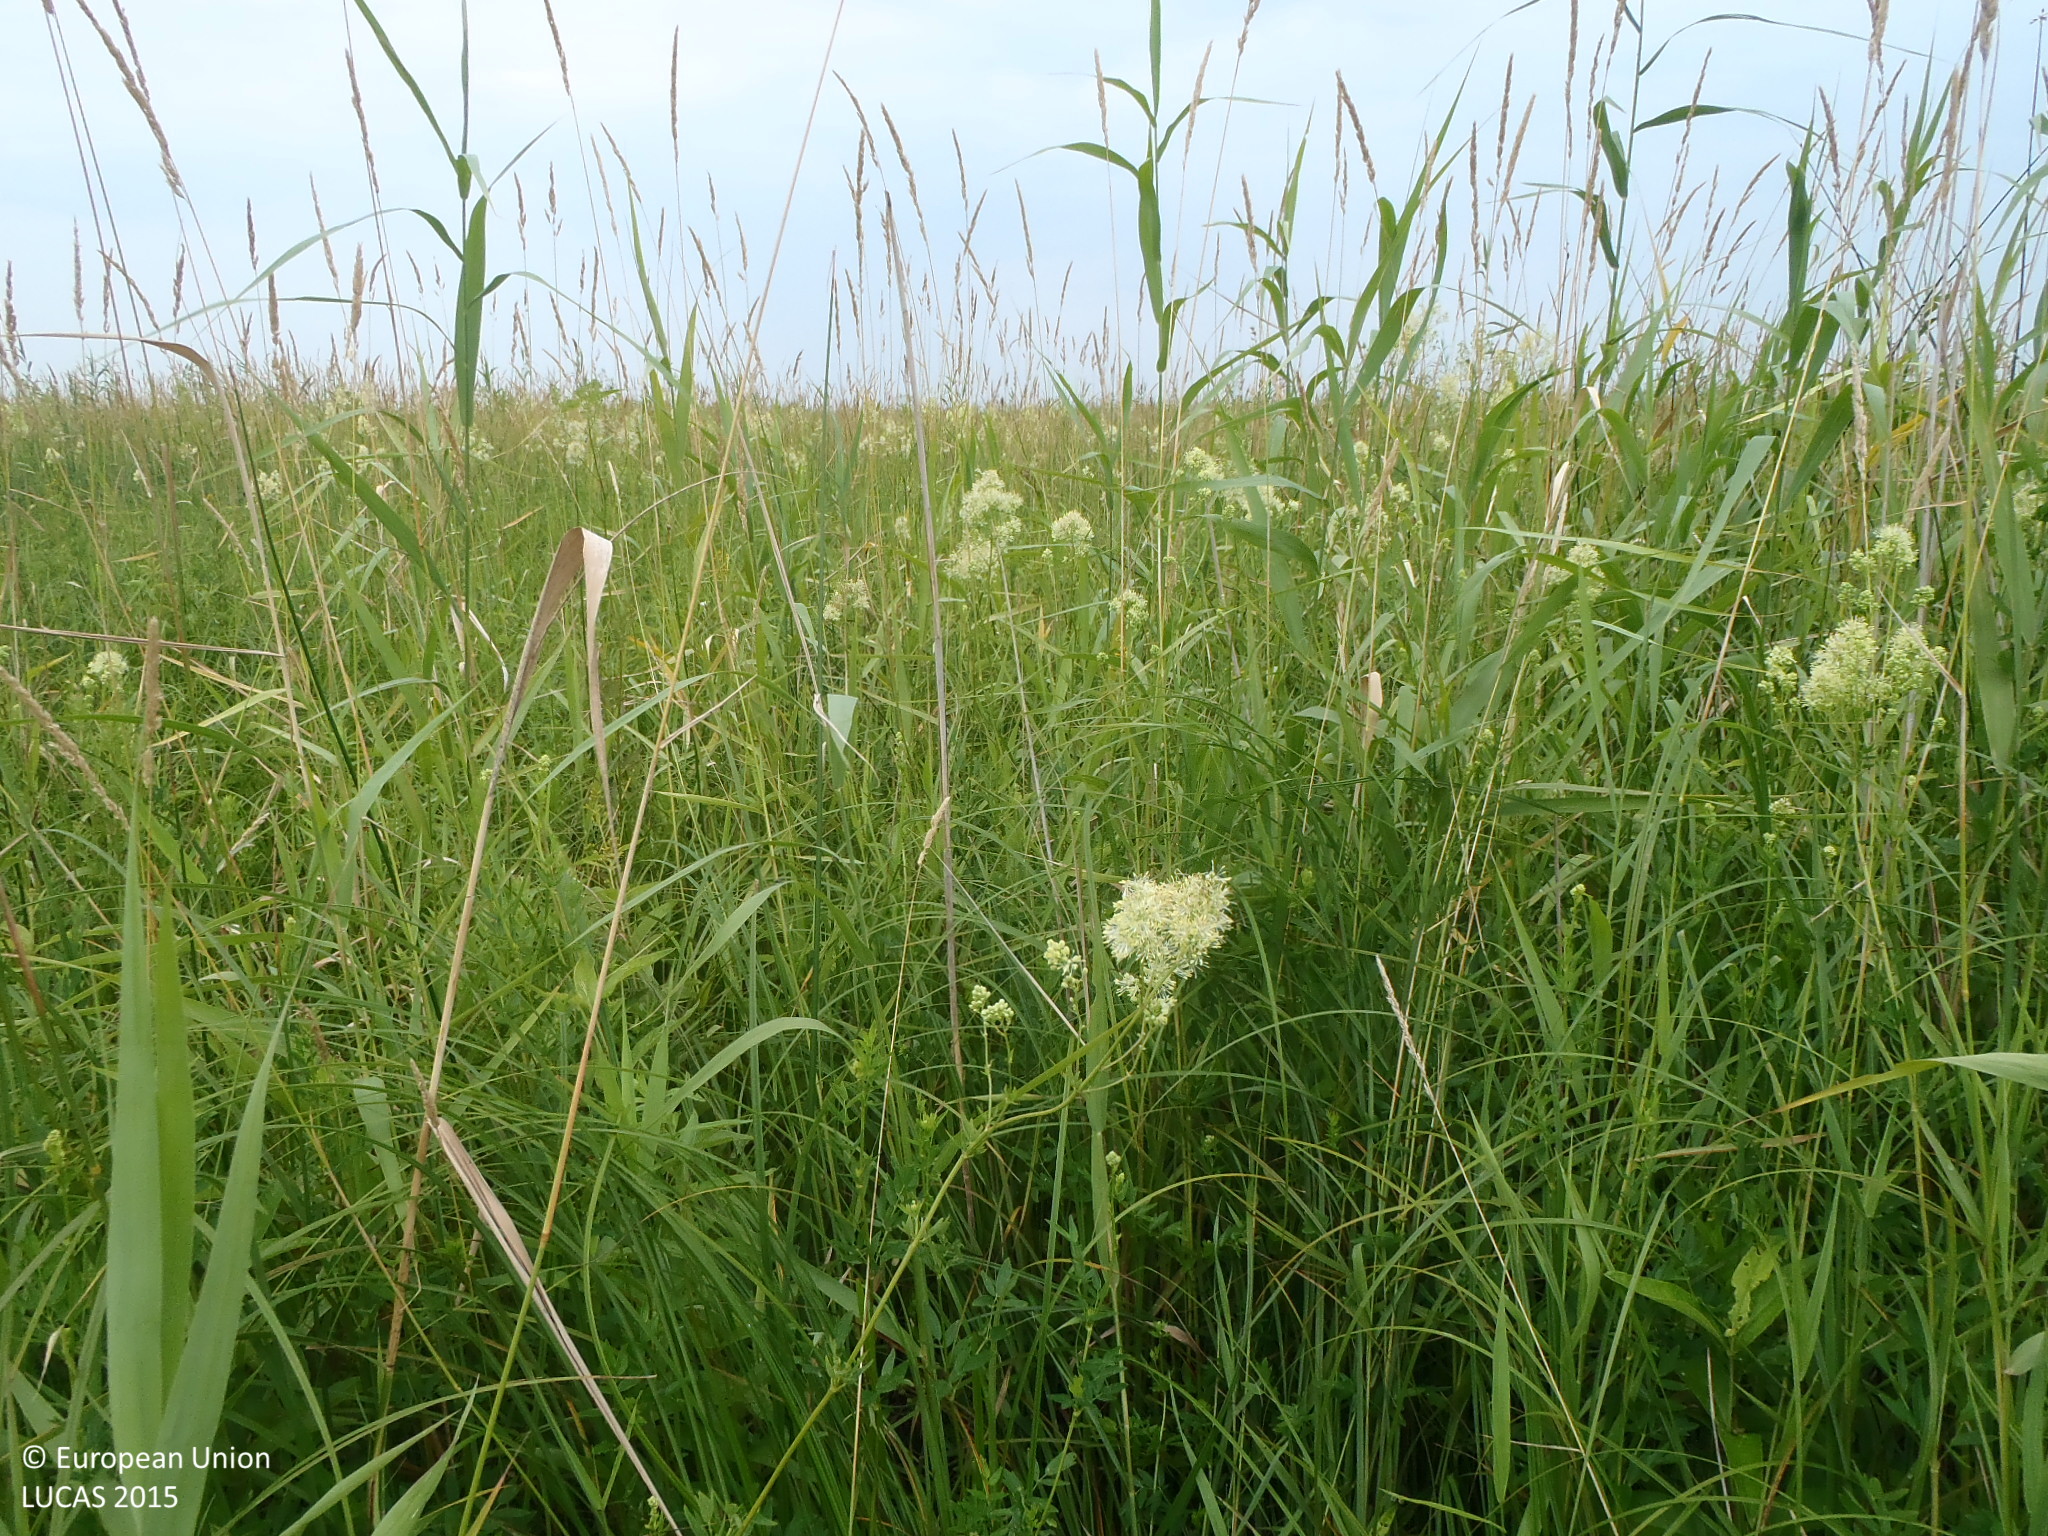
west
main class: Grassland
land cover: Spontaneously vegetated surfaces
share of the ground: > 75 %
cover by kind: herbaceous plants 95 %, shrubs 5 %
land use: Semi-natural and natural areas not in use
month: July
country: BG
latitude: 44.0016
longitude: 26.3312
